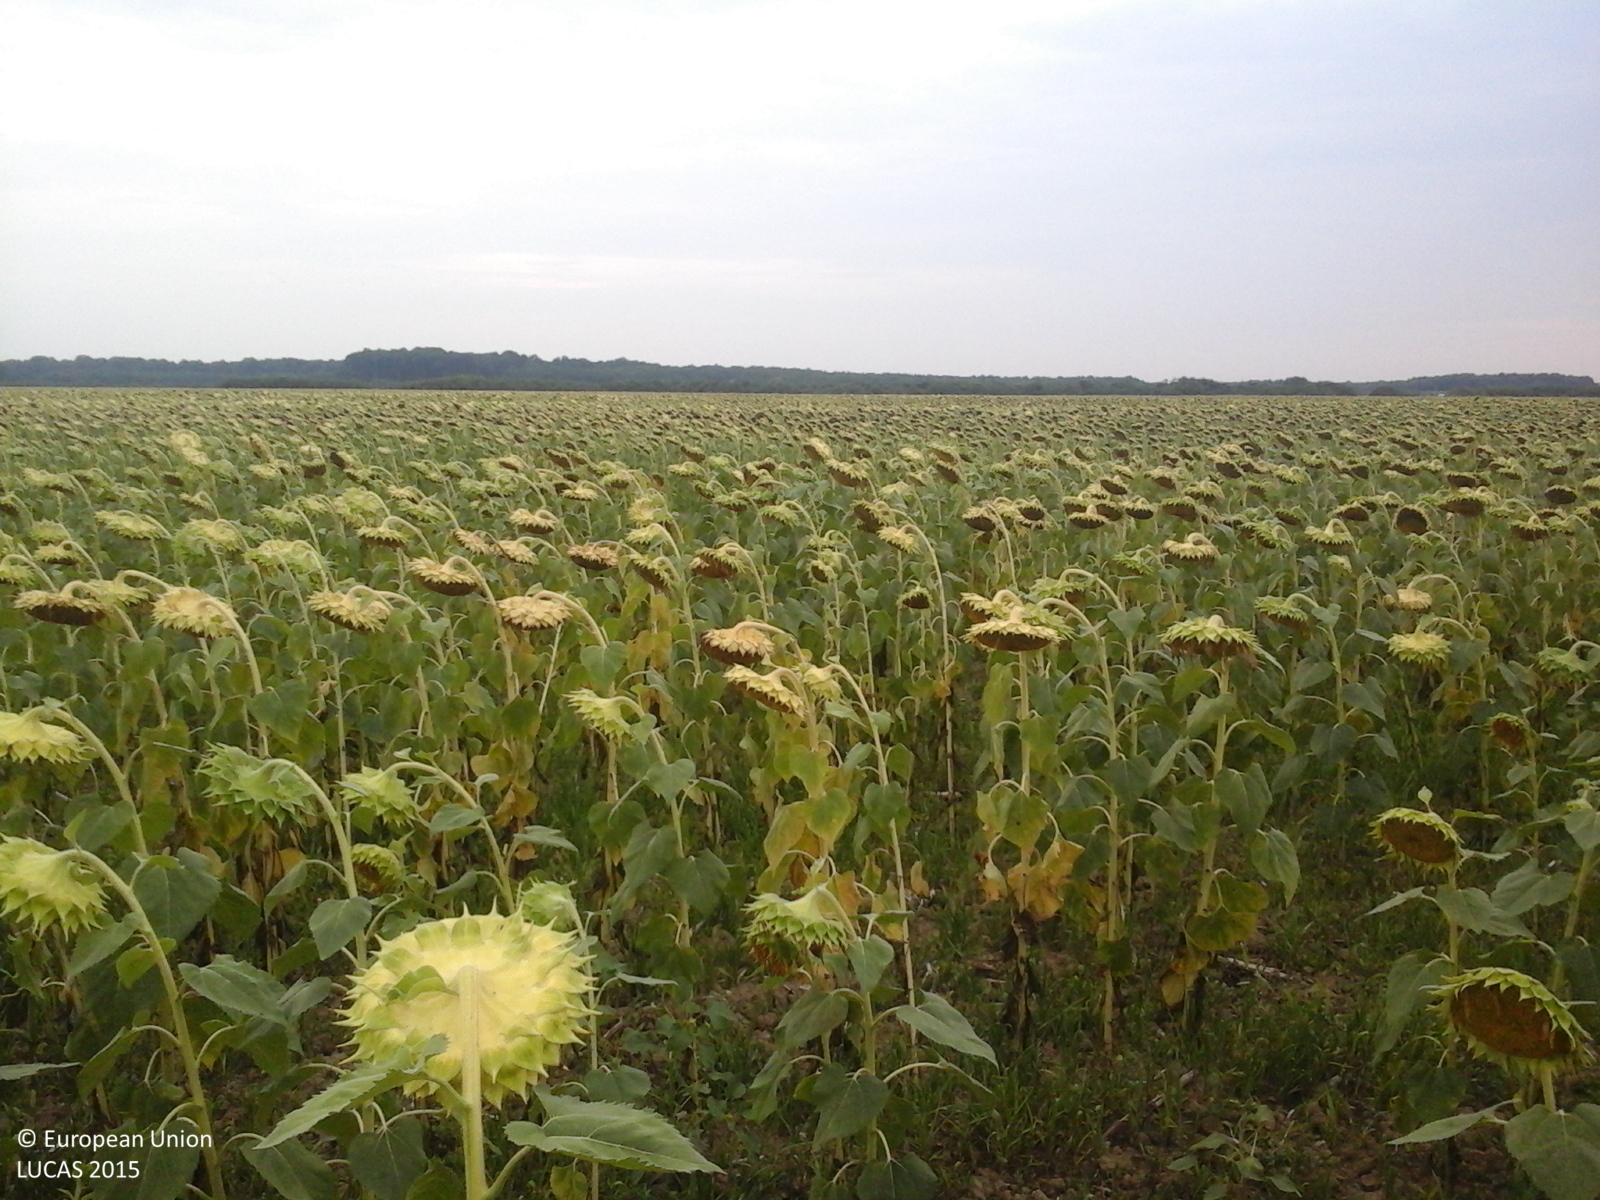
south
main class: Cropland
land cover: Sunflower
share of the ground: > 75 %
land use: Agriculture (excluding fallow land and kitchen gardens)
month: August
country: RO
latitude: 46.5029
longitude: 21.5711
